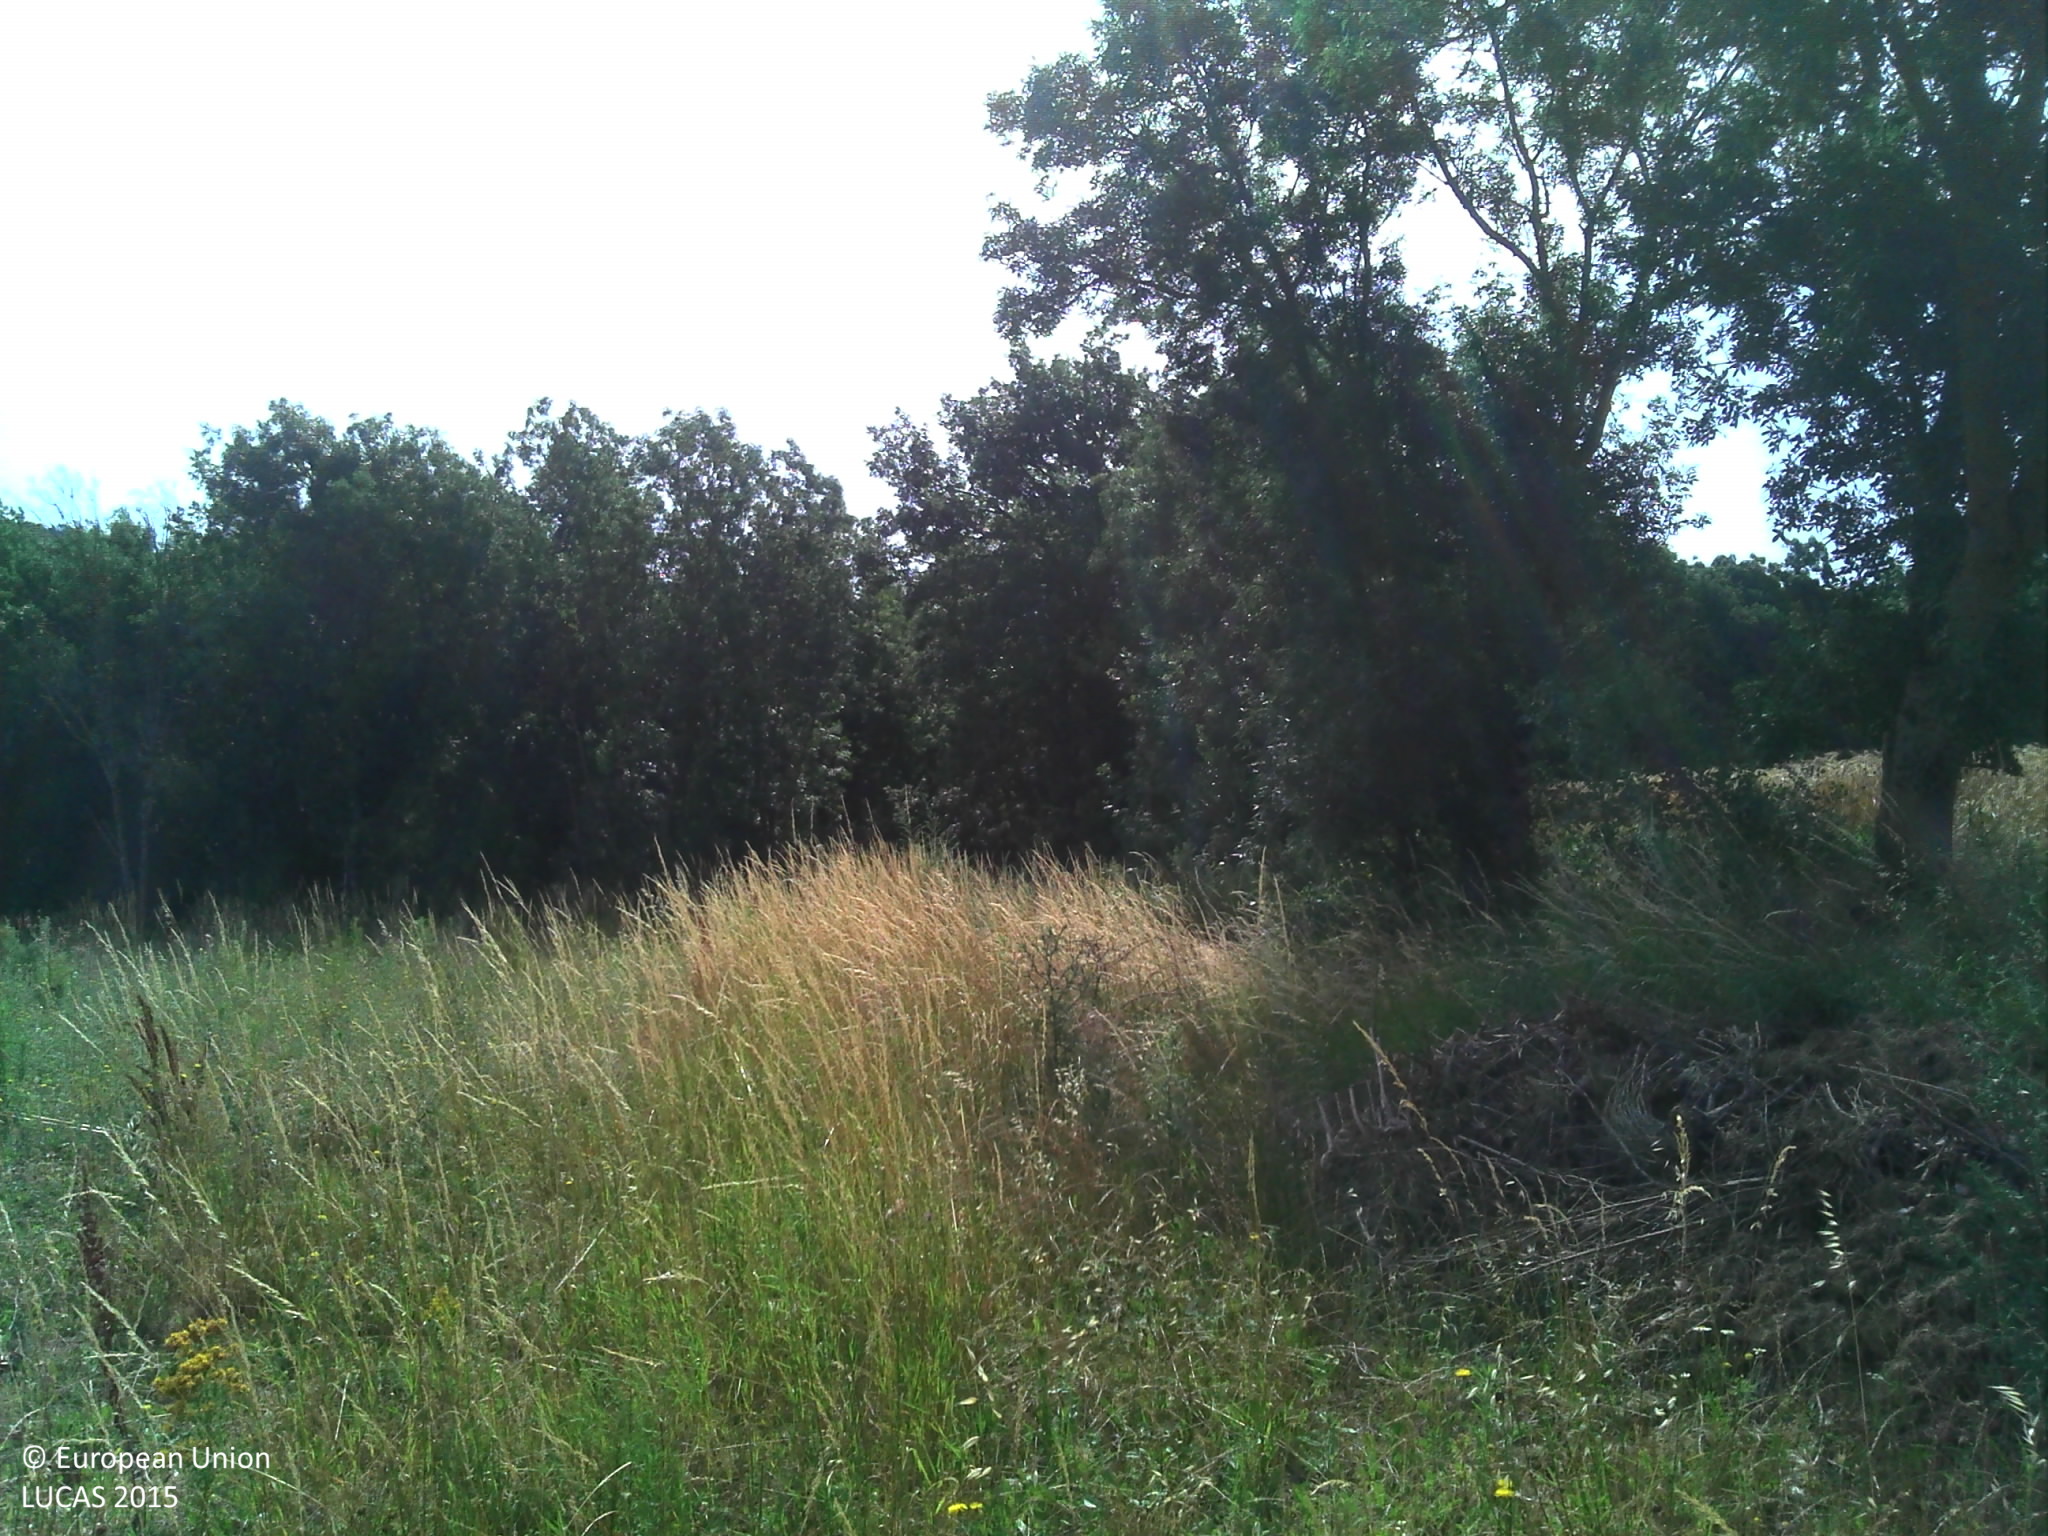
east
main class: Grassland
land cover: Spontaneously vegetated surfaces
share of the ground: > 75 %
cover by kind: herbaceous plants 90 %
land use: Semi-natural and natural areas not in use
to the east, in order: Spontaneously vegetated surfaces; Broadleaved woodland; Spontaneously vegetated surfaces
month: July
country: FR
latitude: 43.5602
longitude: 1.6474
